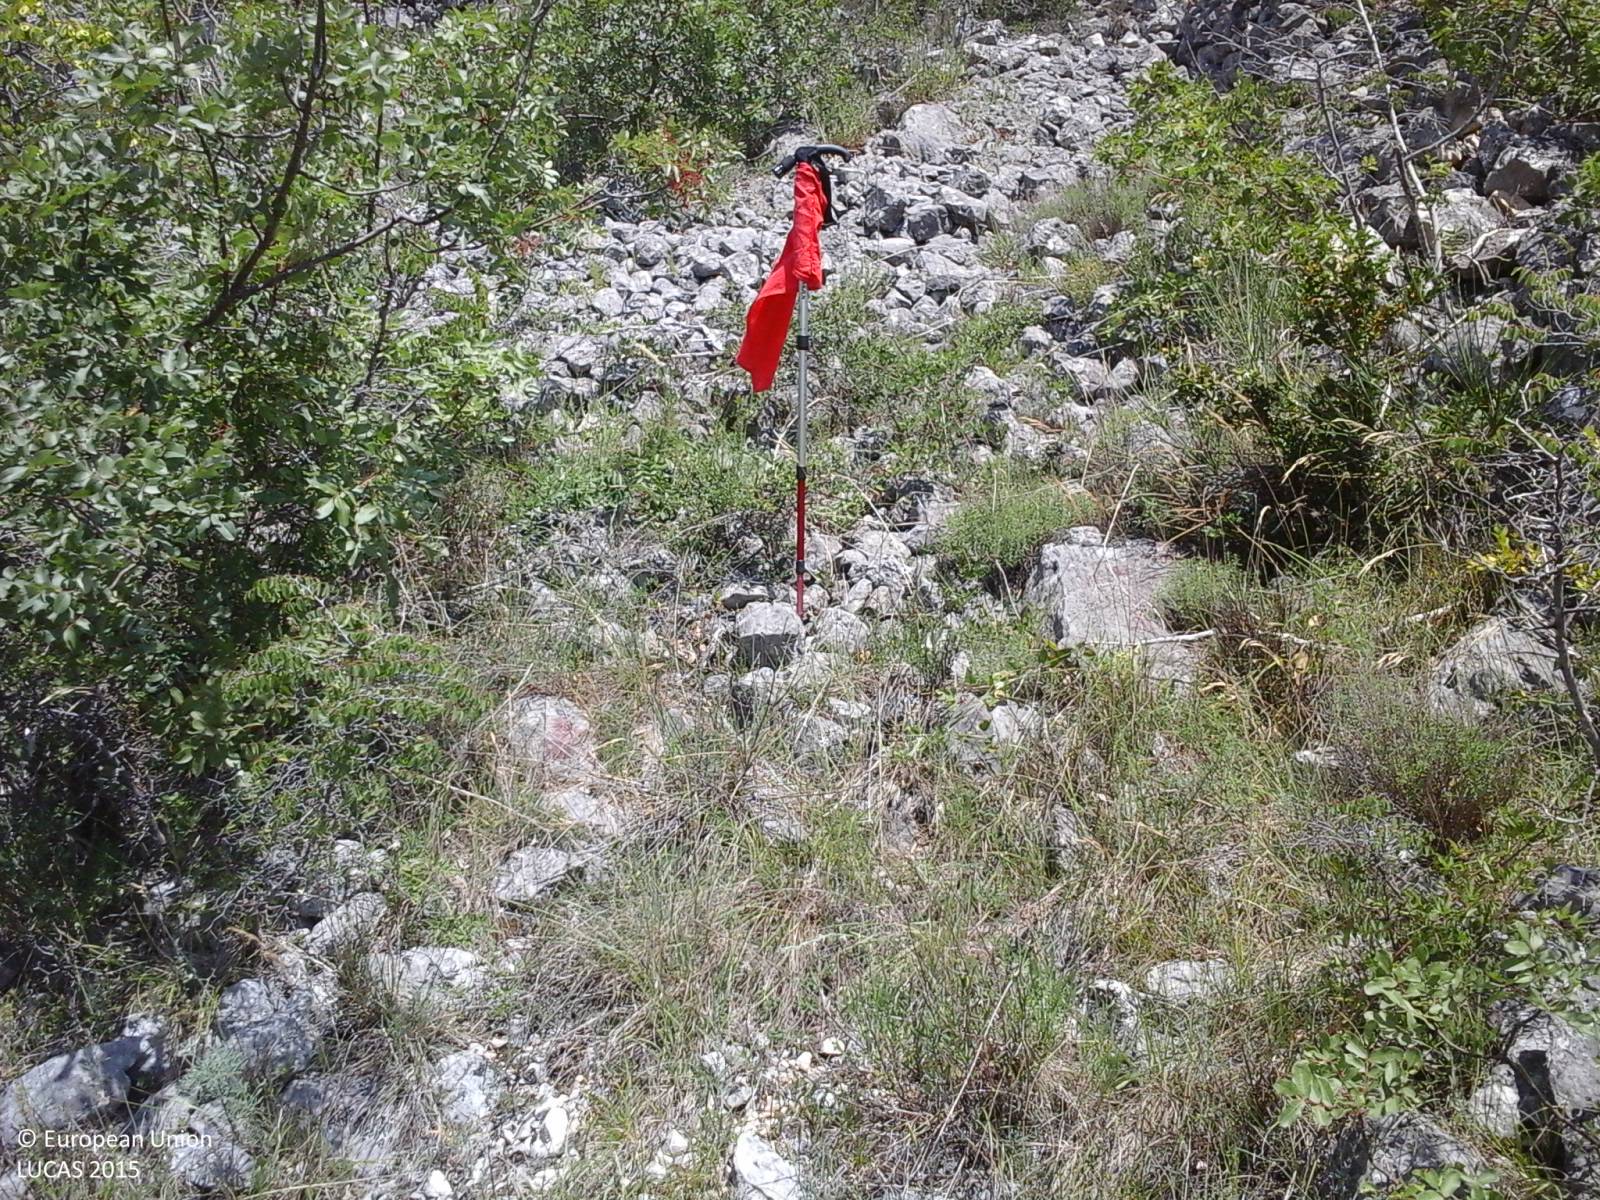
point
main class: Shrubland
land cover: Shrubland without tree cover
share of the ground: 50 - 75 %
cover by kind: shrubs 60 %, unconsolidated bare surface 35 %, herbaceous plants 5 %
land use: Semi-natural and natural areas not in use
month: June
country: IT
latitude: 42.3121
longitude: 13.7854
